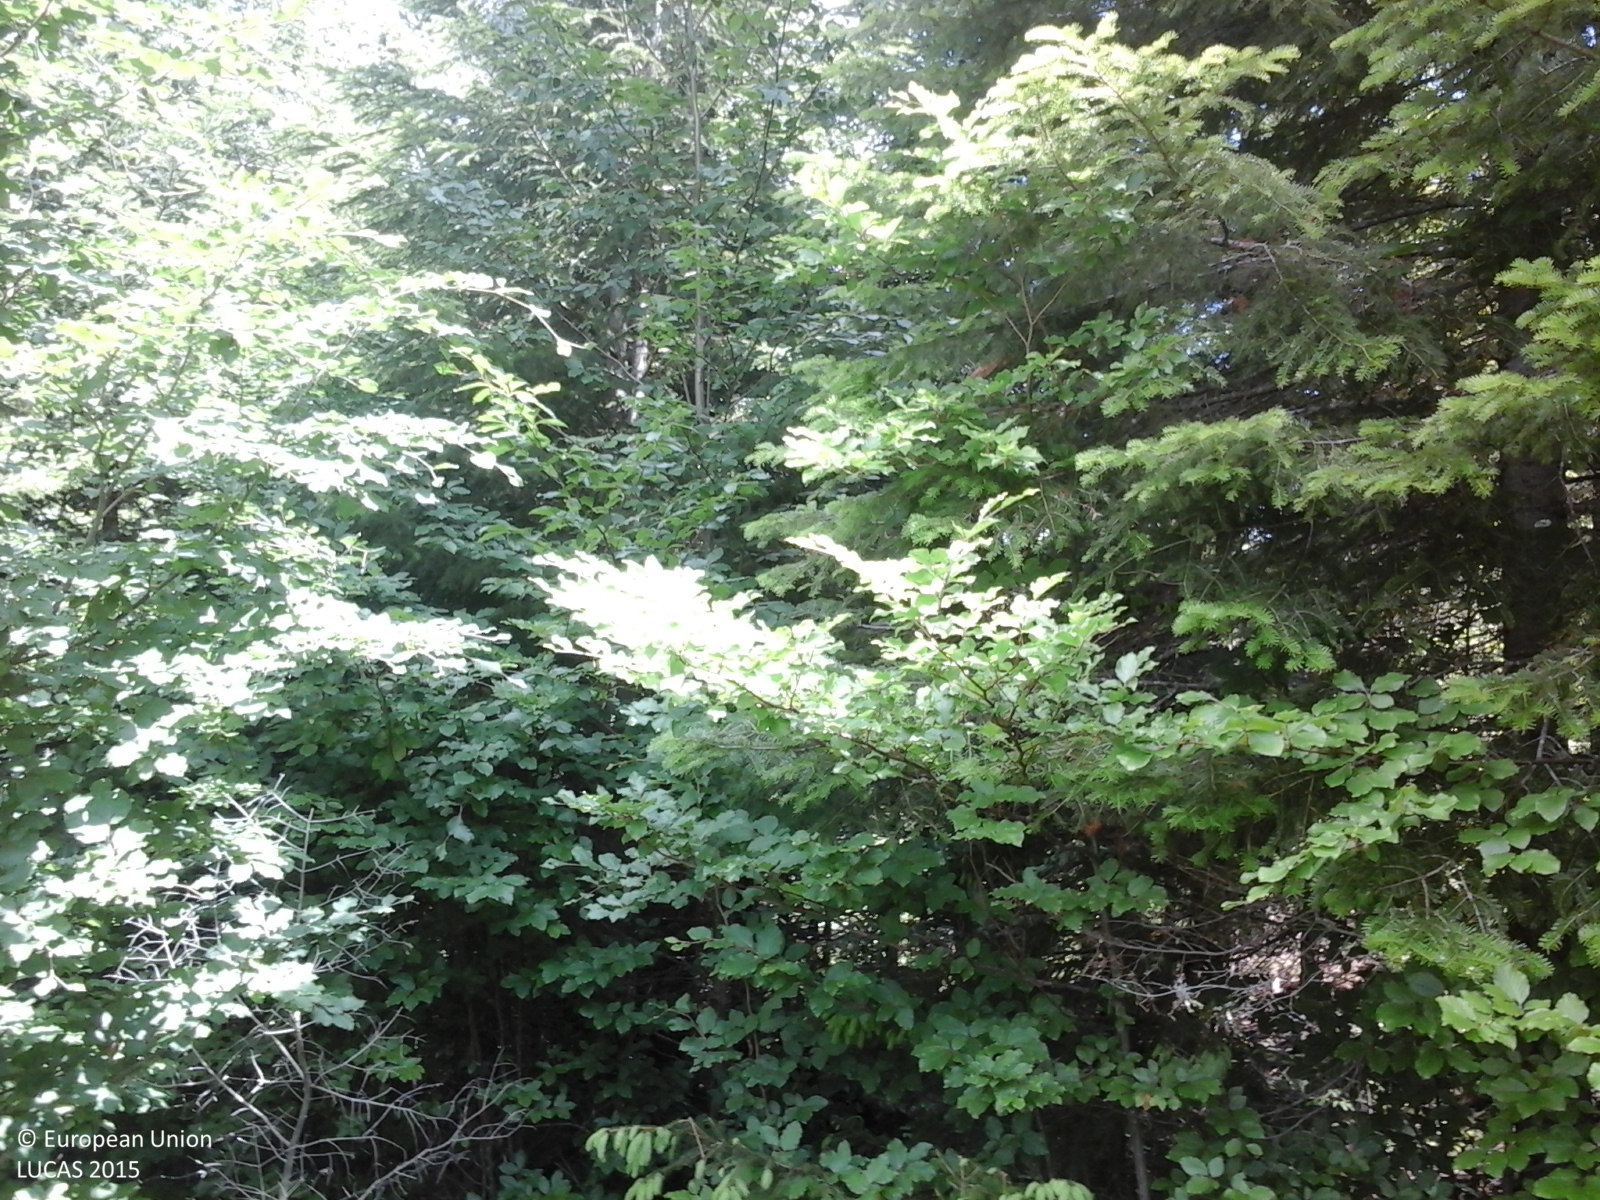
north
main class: Woodland
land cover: Spruce dominated coniferous woodland
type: alpine coniferous forest
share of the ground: > 75 %
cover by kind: coniferous forest trees 95 %, broadleaved forest trees 5 %
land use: Forestry
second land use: Agriculture (excluding fallow land and kitchen gardens)
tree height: > 5 m
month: June
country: RO
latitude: 47.6507
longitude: 25.4938
